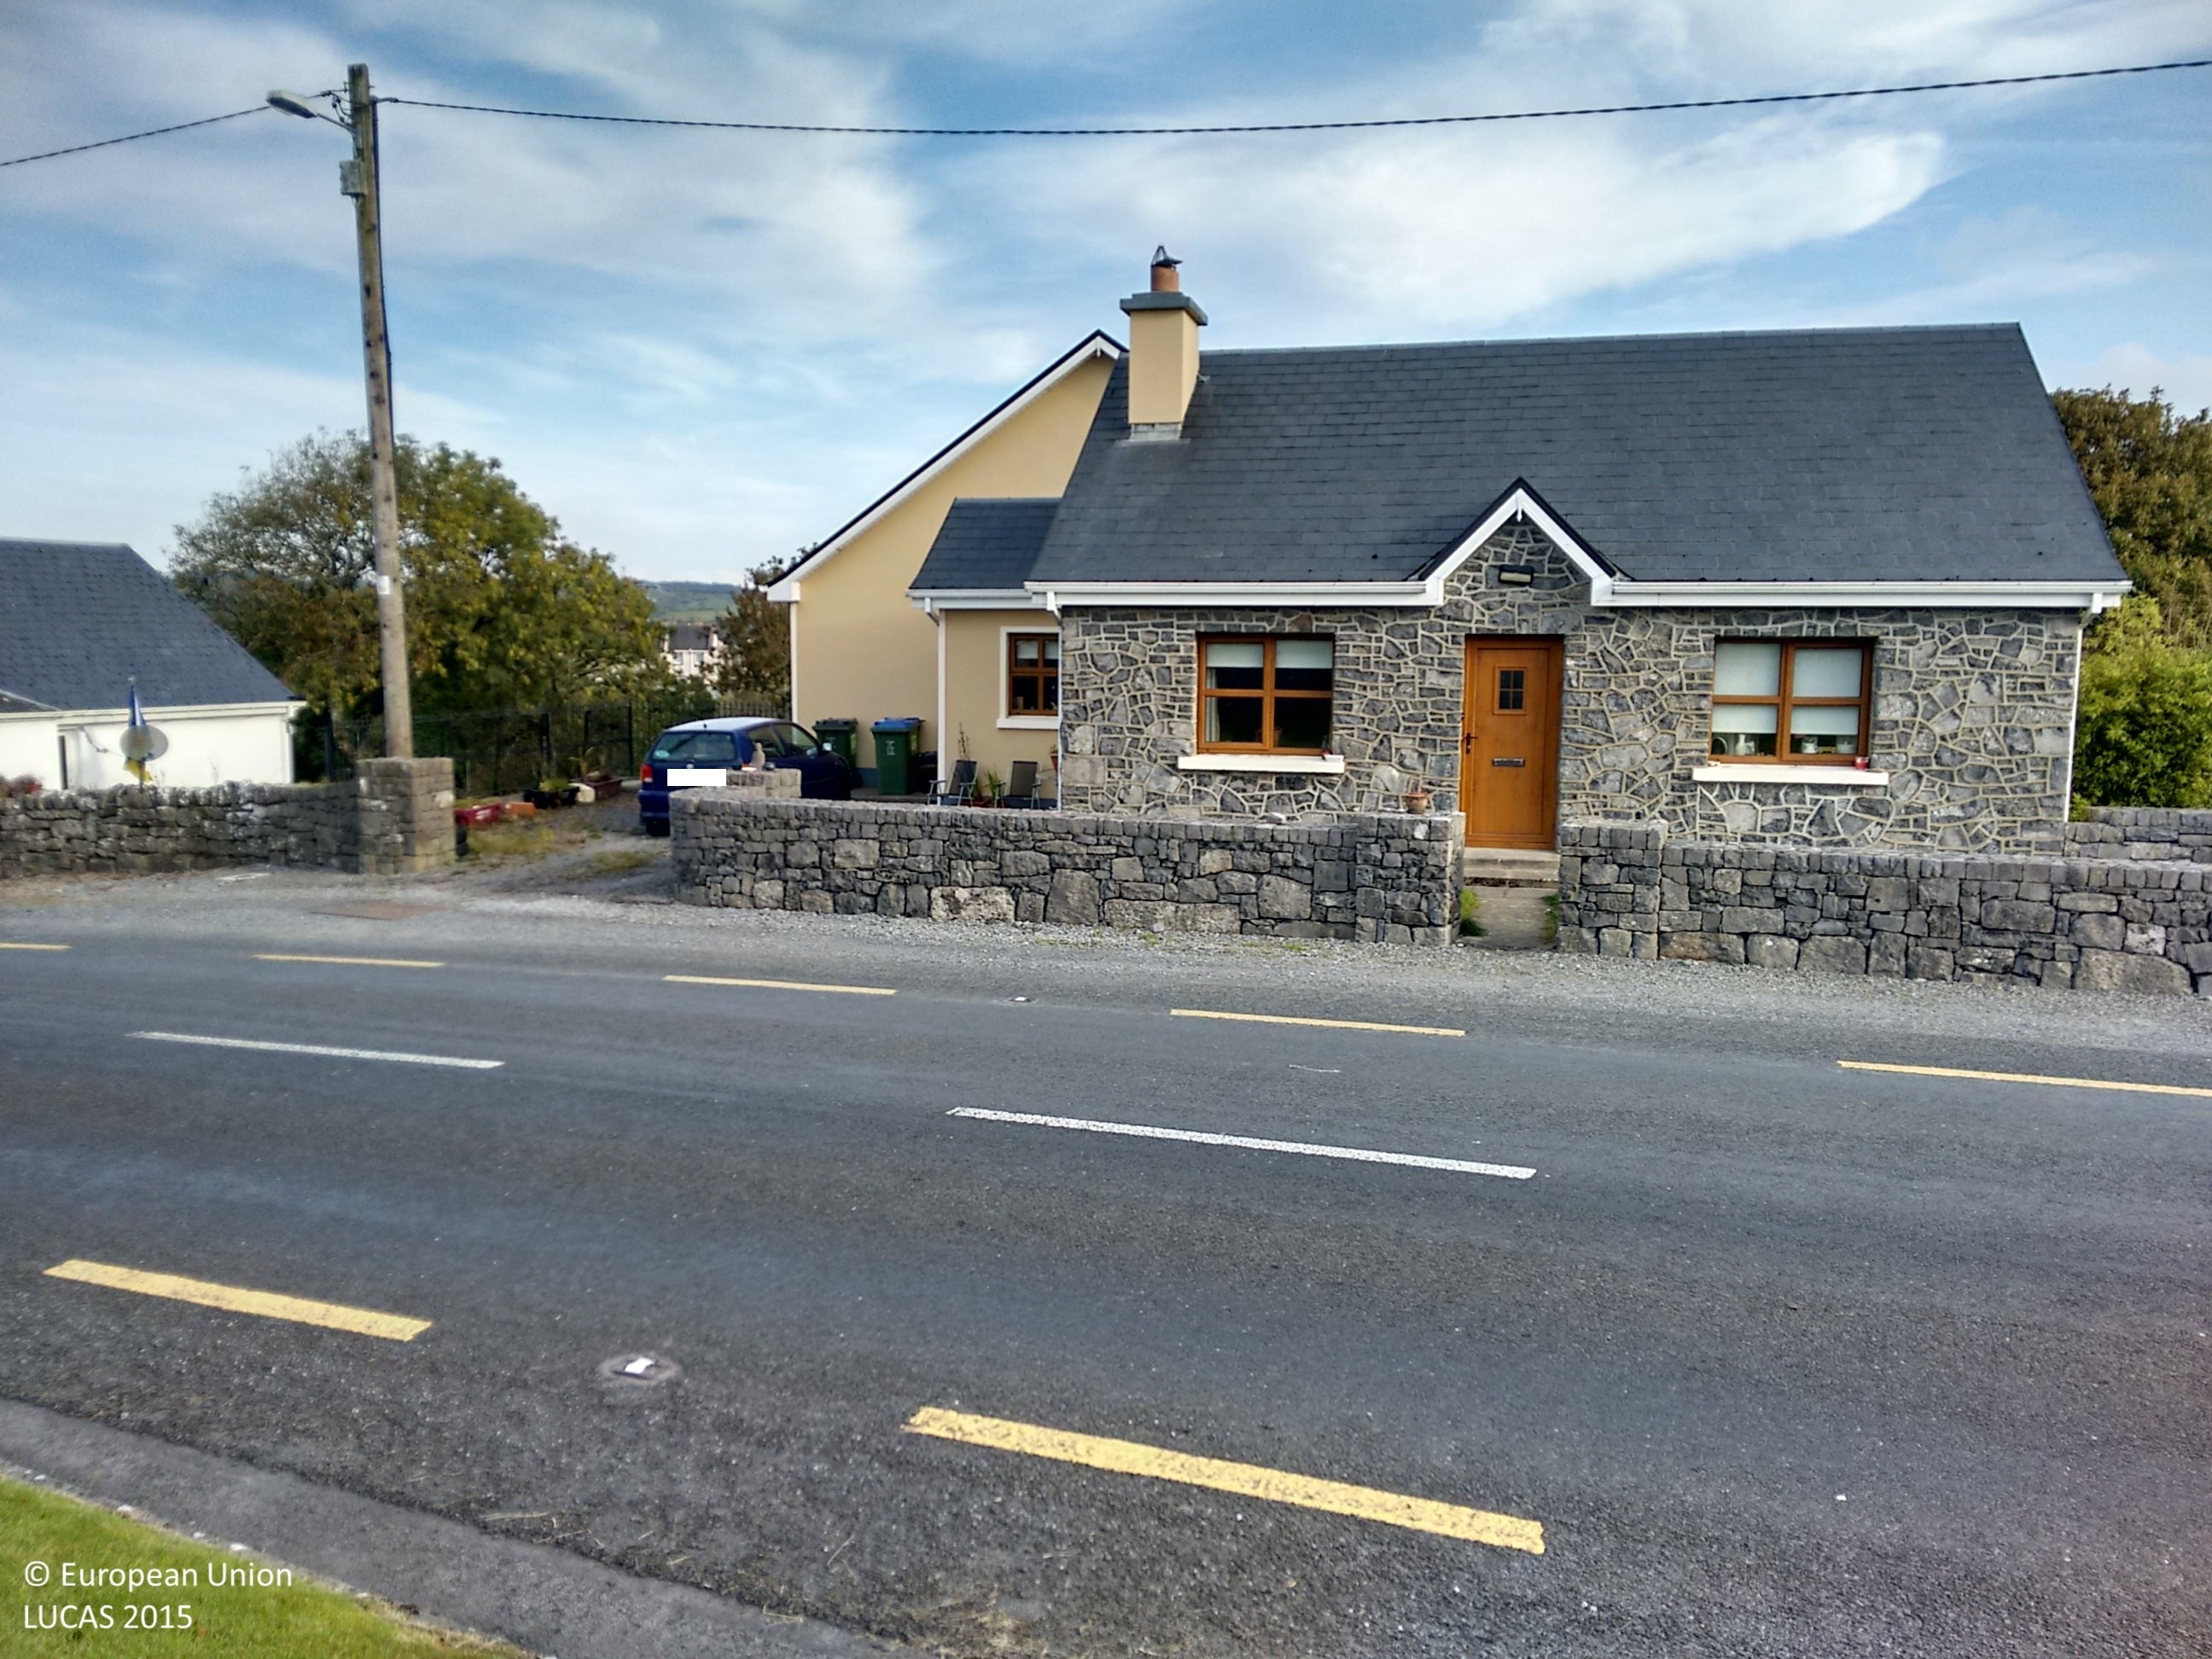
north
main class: Grassland
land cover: Grassland without tree/shrub cover
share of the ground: > 75 %
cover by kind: herbaceous plants 100 %
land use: Agriculture (excluding fallow land and kitchen gardens)
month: September
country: IE
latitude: 52.9890
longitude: -9.2148
